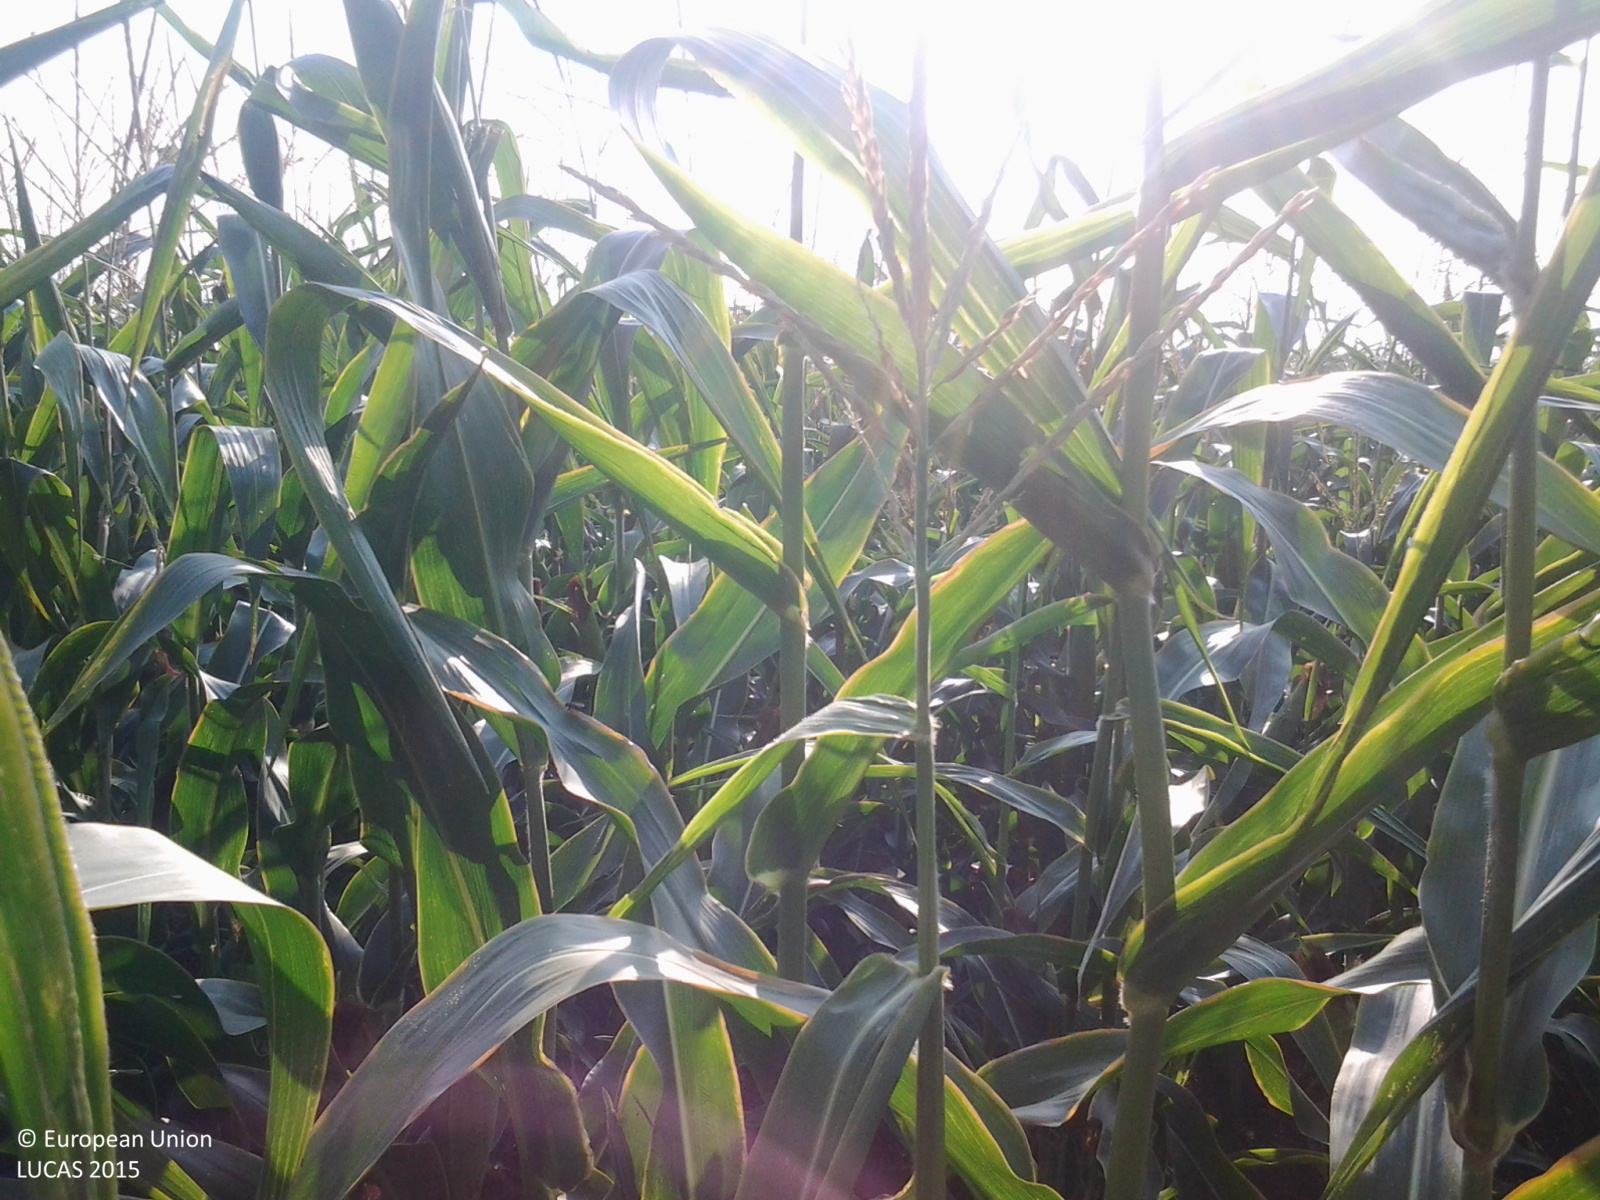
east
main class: Cropland
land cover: Maize
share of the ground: > 75 %
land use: Agriculture (excluding fallow land and kitchen gardens)
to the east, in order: Maize; Tracks; Sunflower
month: July
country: HU
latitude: 46.9681
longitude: 20.7697
